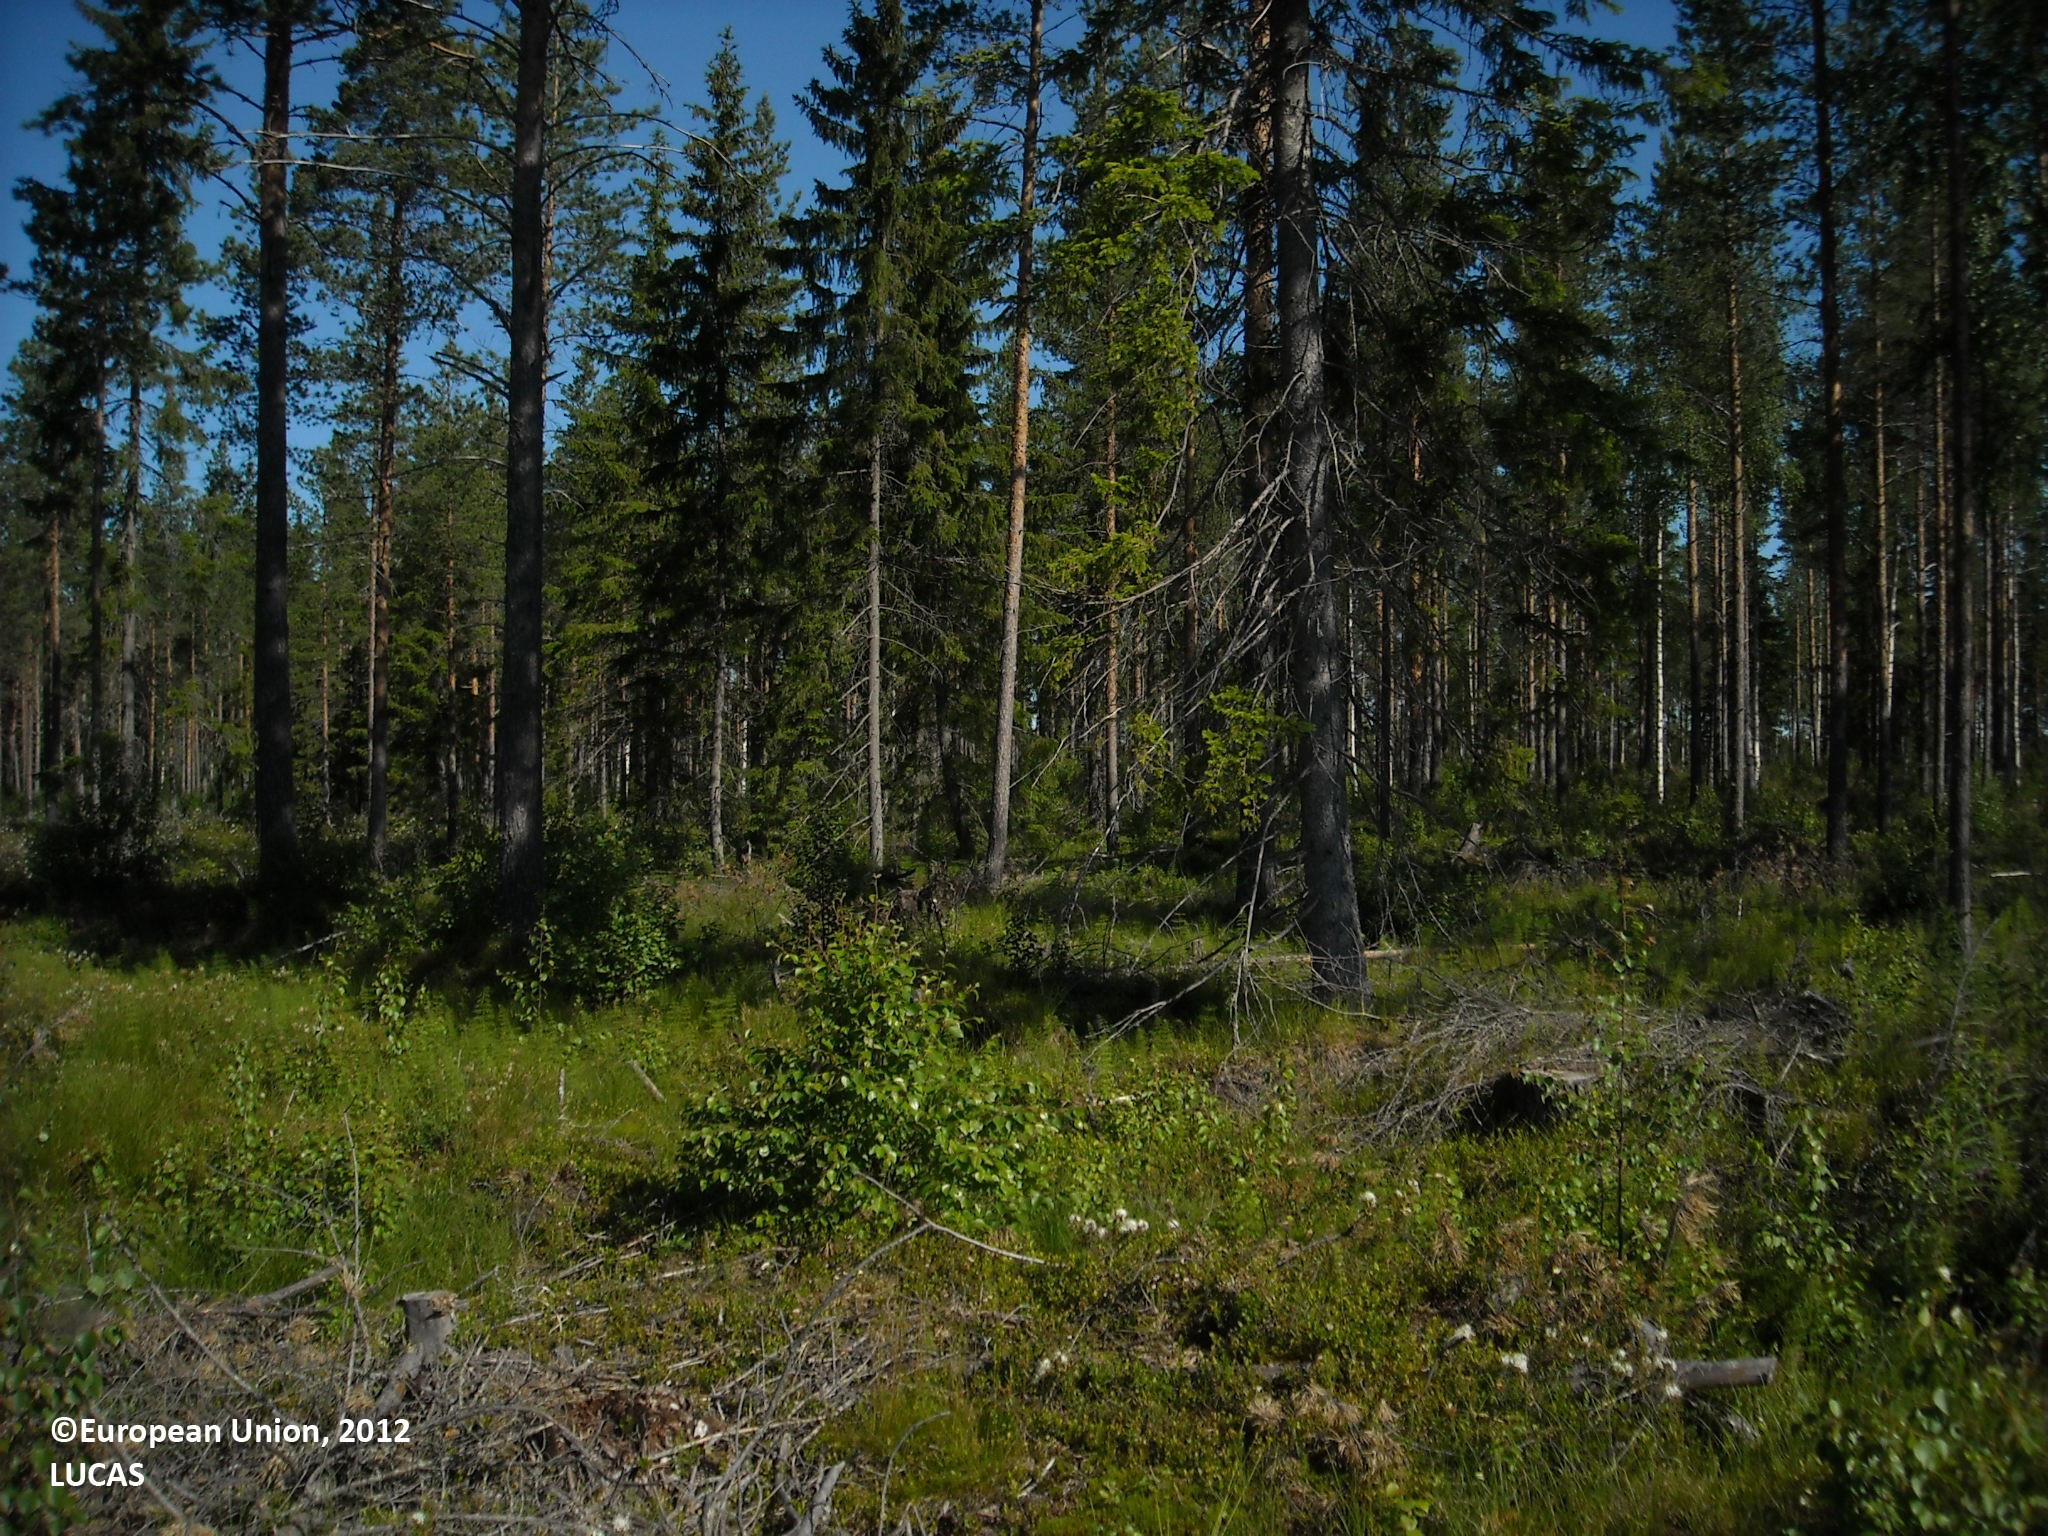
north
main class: Woodland
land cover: Pine dominated coniferous woodland
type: boreal forest
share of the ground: 25 - 50 %
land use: Forestry
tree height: > 5 m
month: July
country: FI
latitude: 64.9215
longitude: 27.4971
